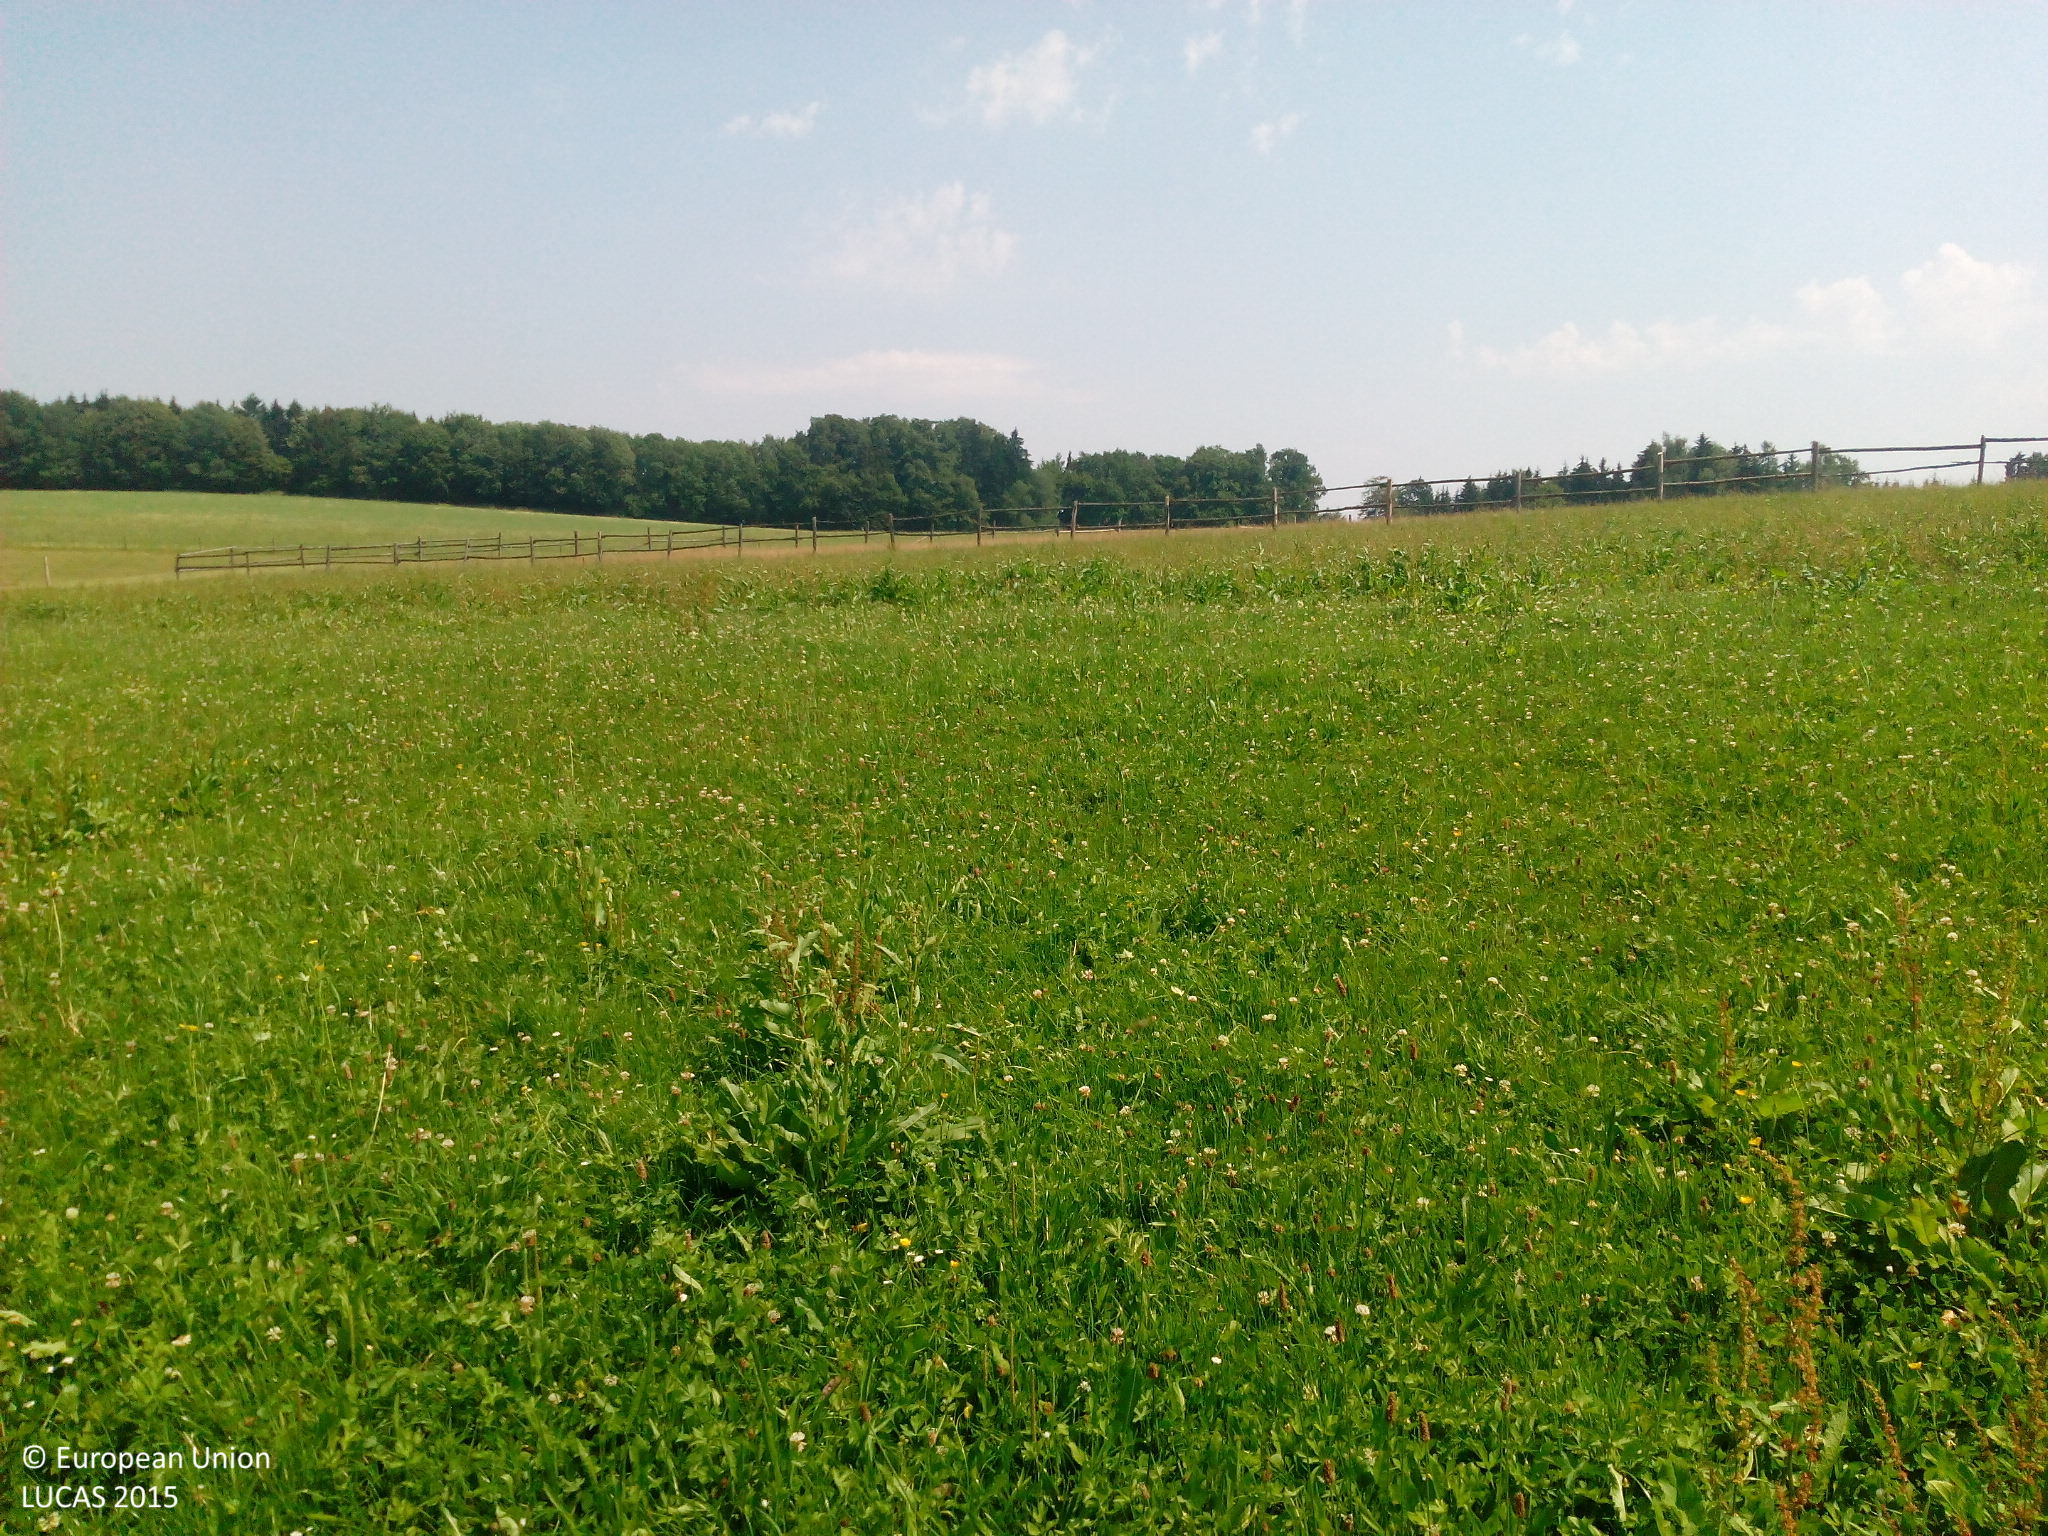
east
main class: Grassland
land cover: Grassland without tree/shrub cover
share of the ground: > 75 %
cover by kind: herbaceous plants 100 %
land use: Agriculture (excluding fallow land and kitchen gardens)
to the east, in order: Grassland without tree/shrub cover; Tracks; Fences; Grassland without tree/shrub cover; Fences; Grassland without tree/shrub cover; Fences; Grassland without tree/shrub cover
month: July
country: DE
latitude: 47.8615
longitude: 9.3188
